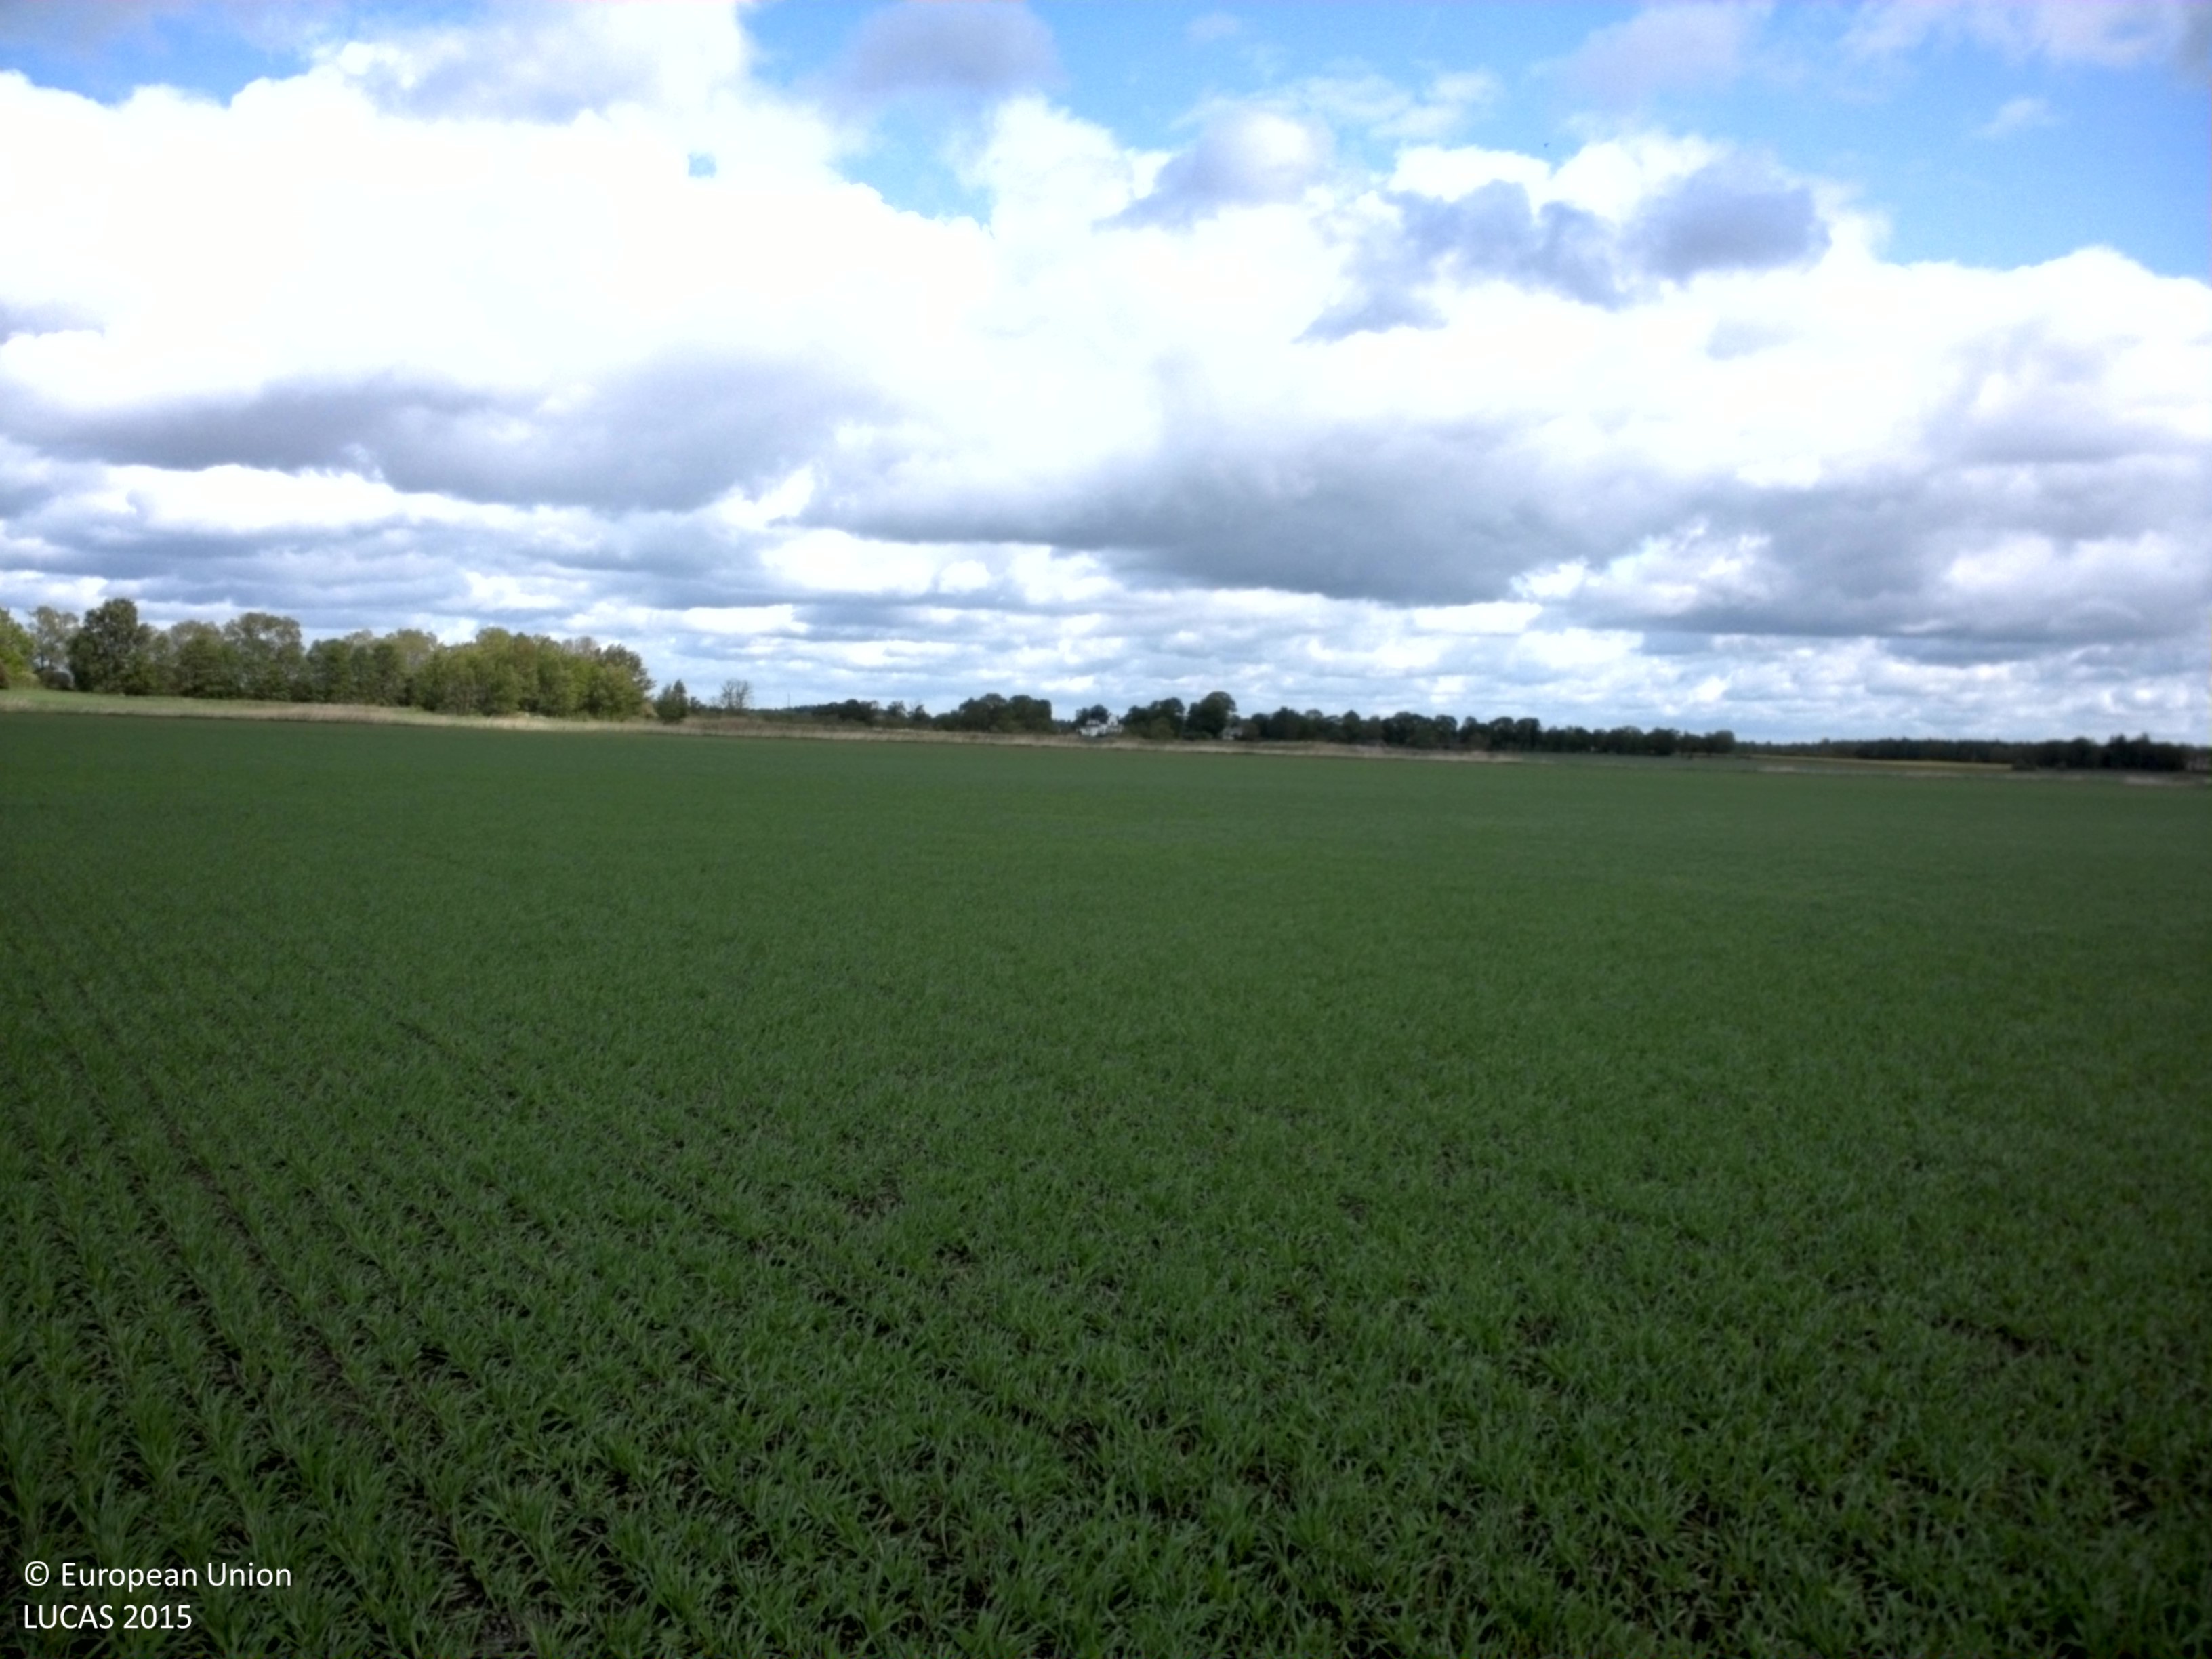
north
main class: Cropland
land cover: Common wheat
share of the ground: 50 - 75 %
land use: Agriculture (excluding fallow land and kitchen gardens)
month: June
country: SE
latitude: 58.4443
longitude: 15.6310
